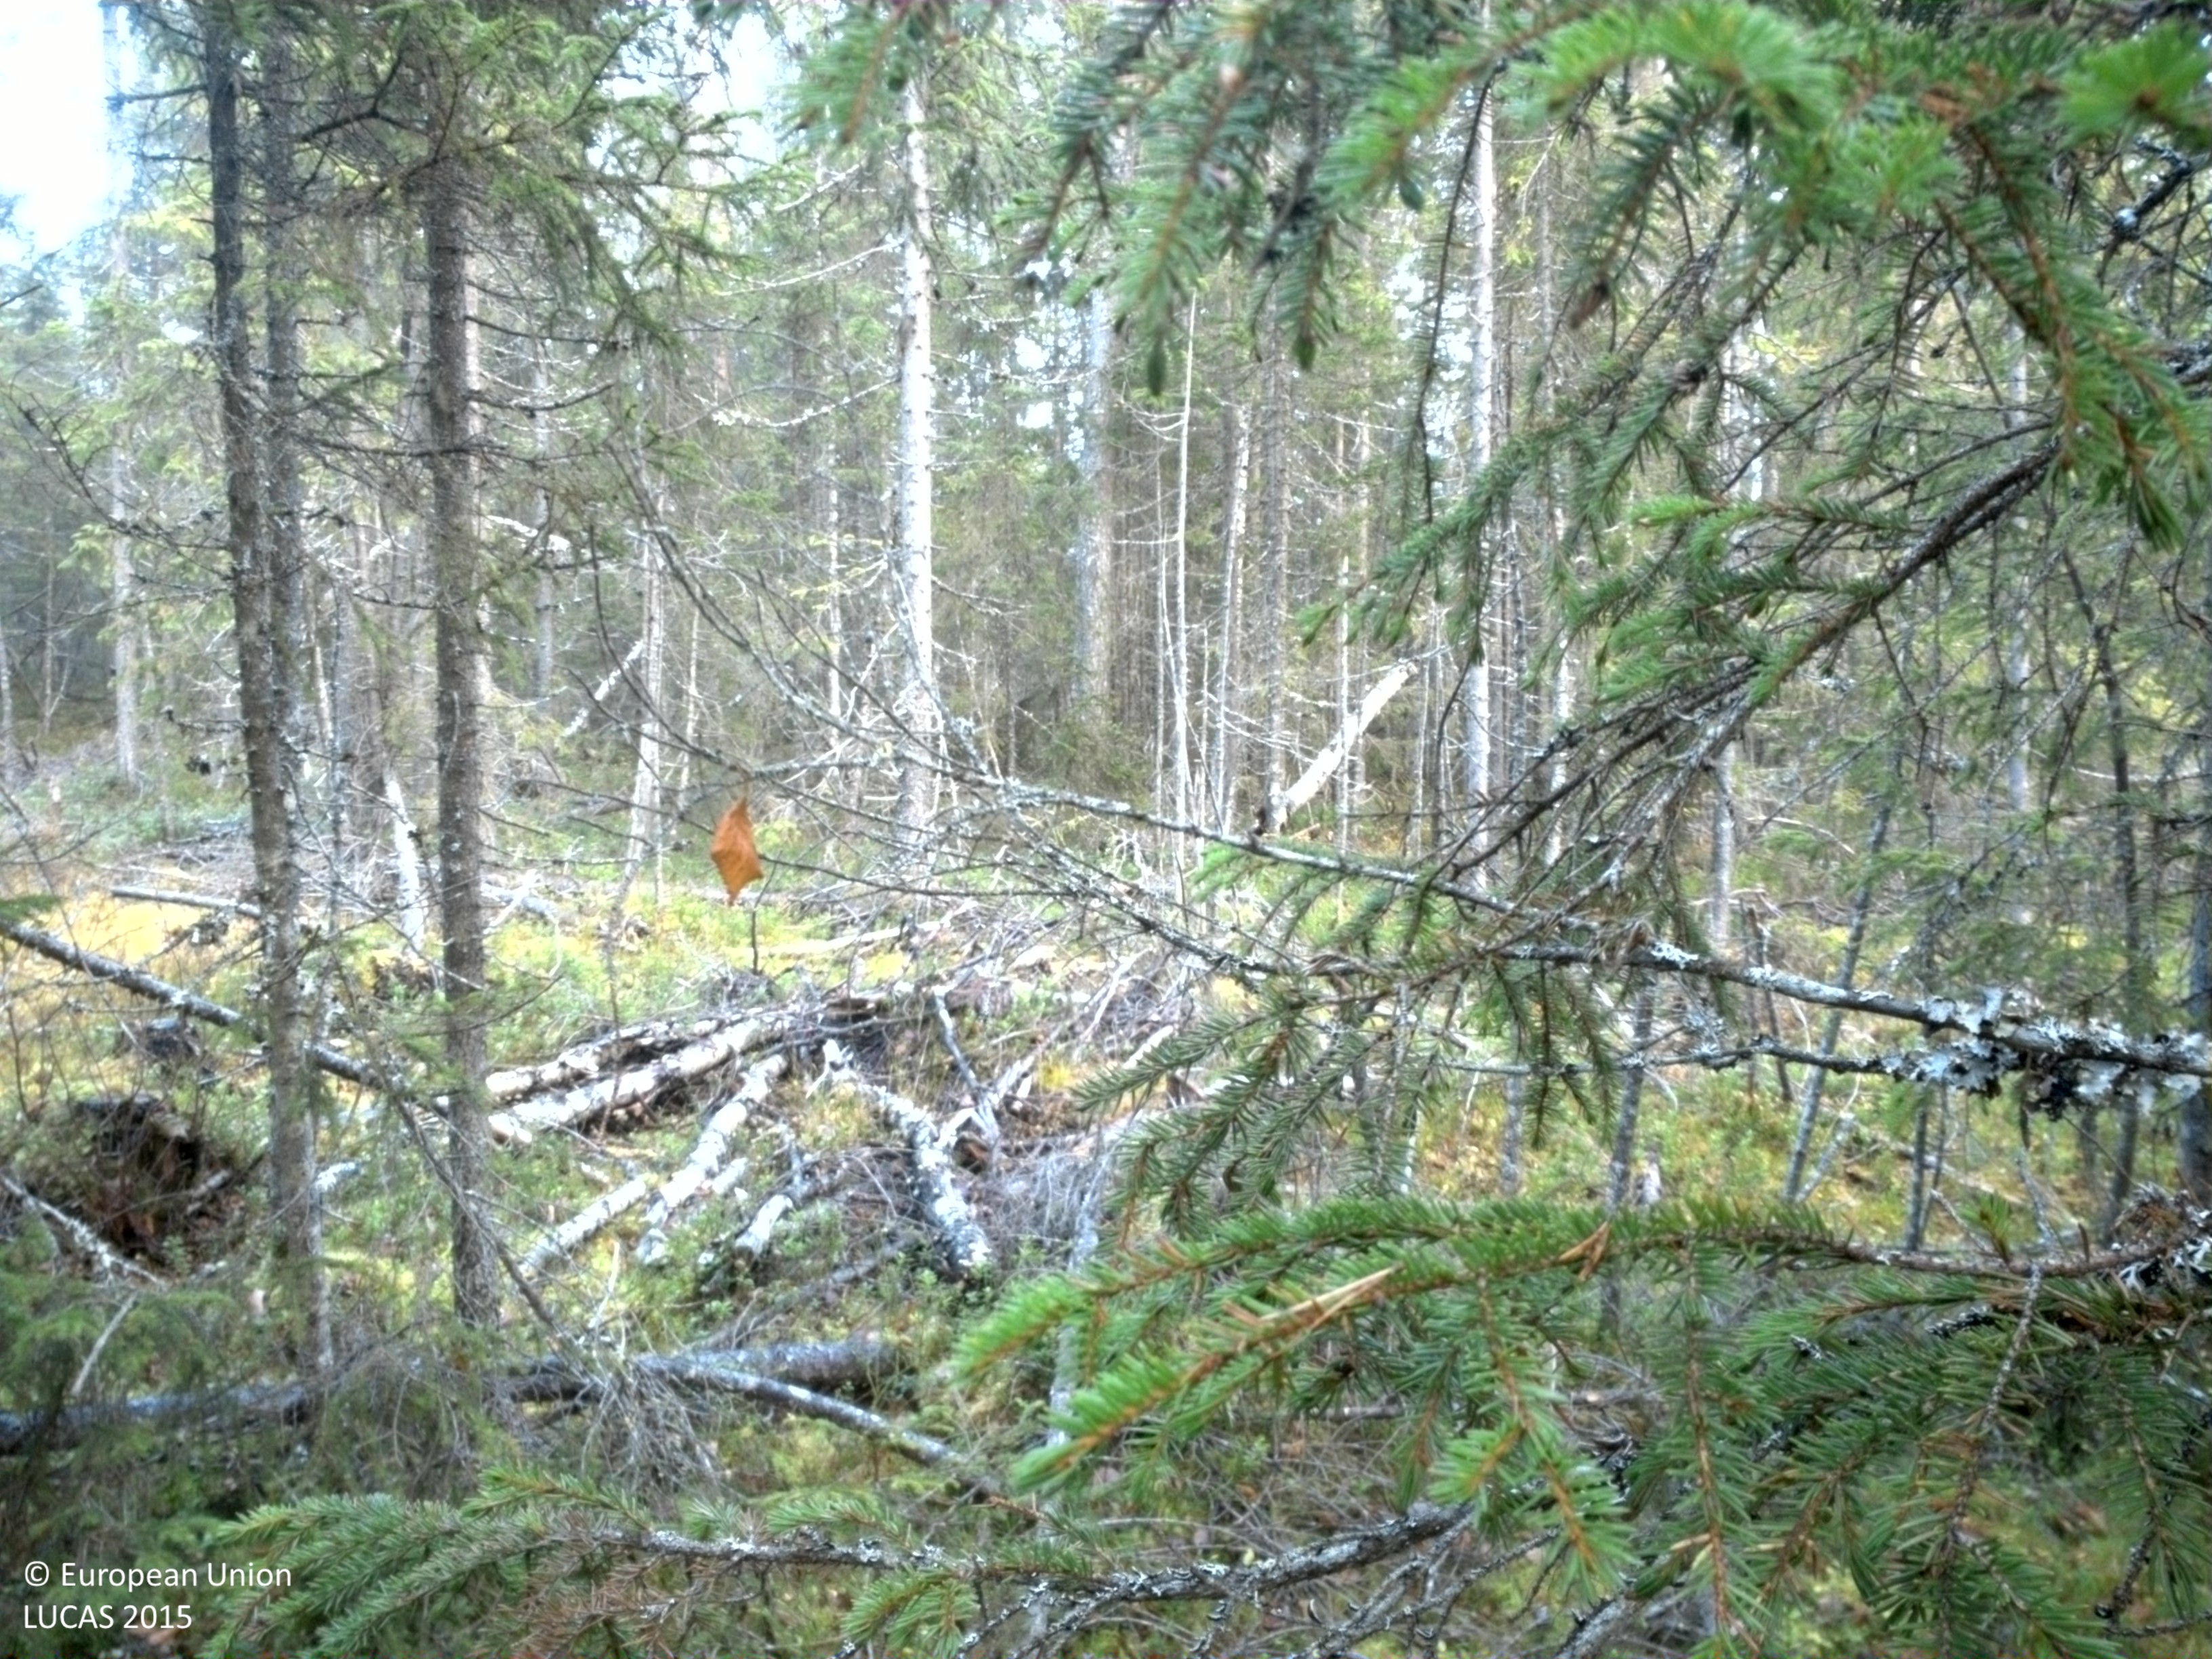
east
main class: Woodland
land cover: Spruce dominated coniferous woodland
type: boreal forest
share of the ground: 50 - 75 %
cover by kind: coniferous forest trees 65 %, shrubs 15 %, herbaceous plants 15 %, broadleaved forest trees 5 %
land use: Forestry
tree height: > 5 m
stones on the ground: < 10 %
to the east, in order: Spruce dominated coniferous woodland; Shrubland without tree cover; Spruce dominated mixed woodland; Ditches and canals; Shrubland with sparse tree cover; Paved roads, cycling and walking lanes; Shruby margins; Ditches and canals; Spruce dominated mixed woodland; Other coniferous woodland; Other mixed woodland; Pine dominated mixed woodland
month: October
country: SE
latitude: 64.5483
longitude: 16.6619
